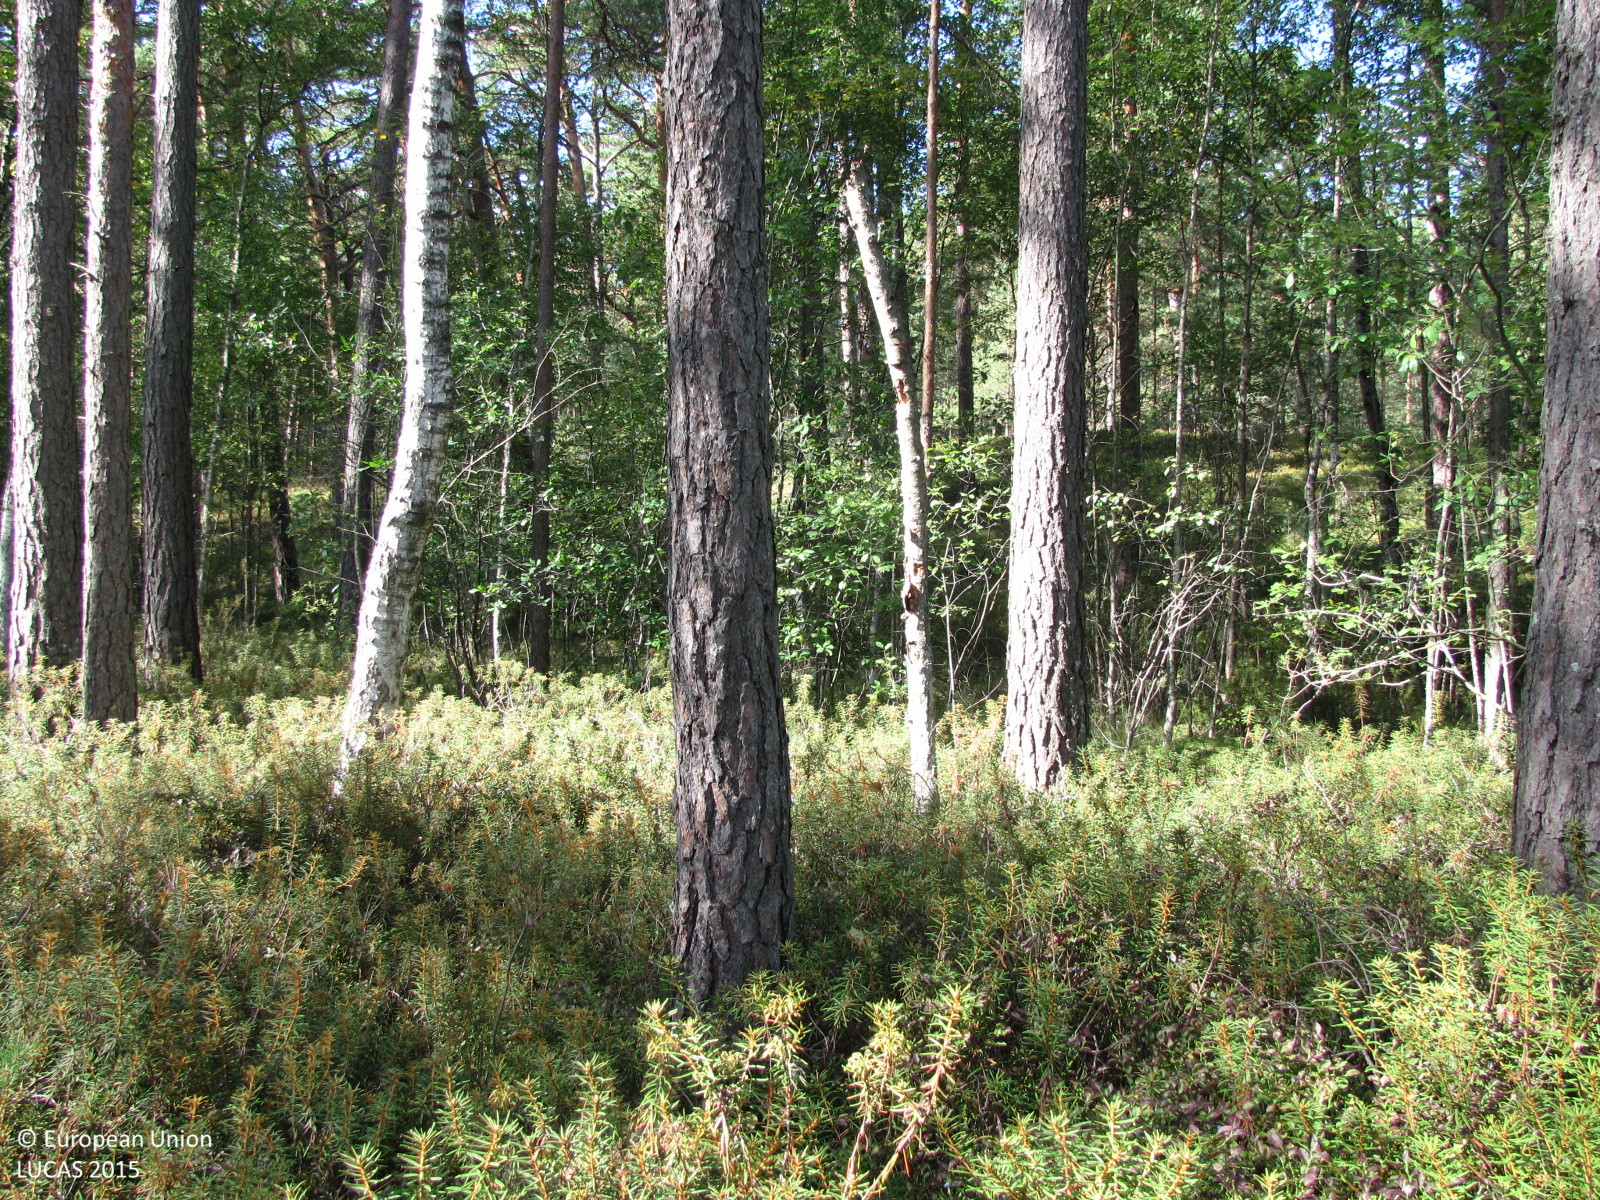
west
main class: Woodland
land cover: Pine dominated mixed woodland
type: hemiboreal forest and nemoral coniferous forest and mixed broadleaved-coniferous forest
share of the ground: 50 - 75 %
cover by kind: herbaceous plants 40 %, coniferous forest trees 30 %, broadleaved forest trees 30 %
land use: Semi-natural and natural areas not in use
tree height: > 5 m
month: September
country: LV
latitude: 57.1573
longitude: 24.2897
